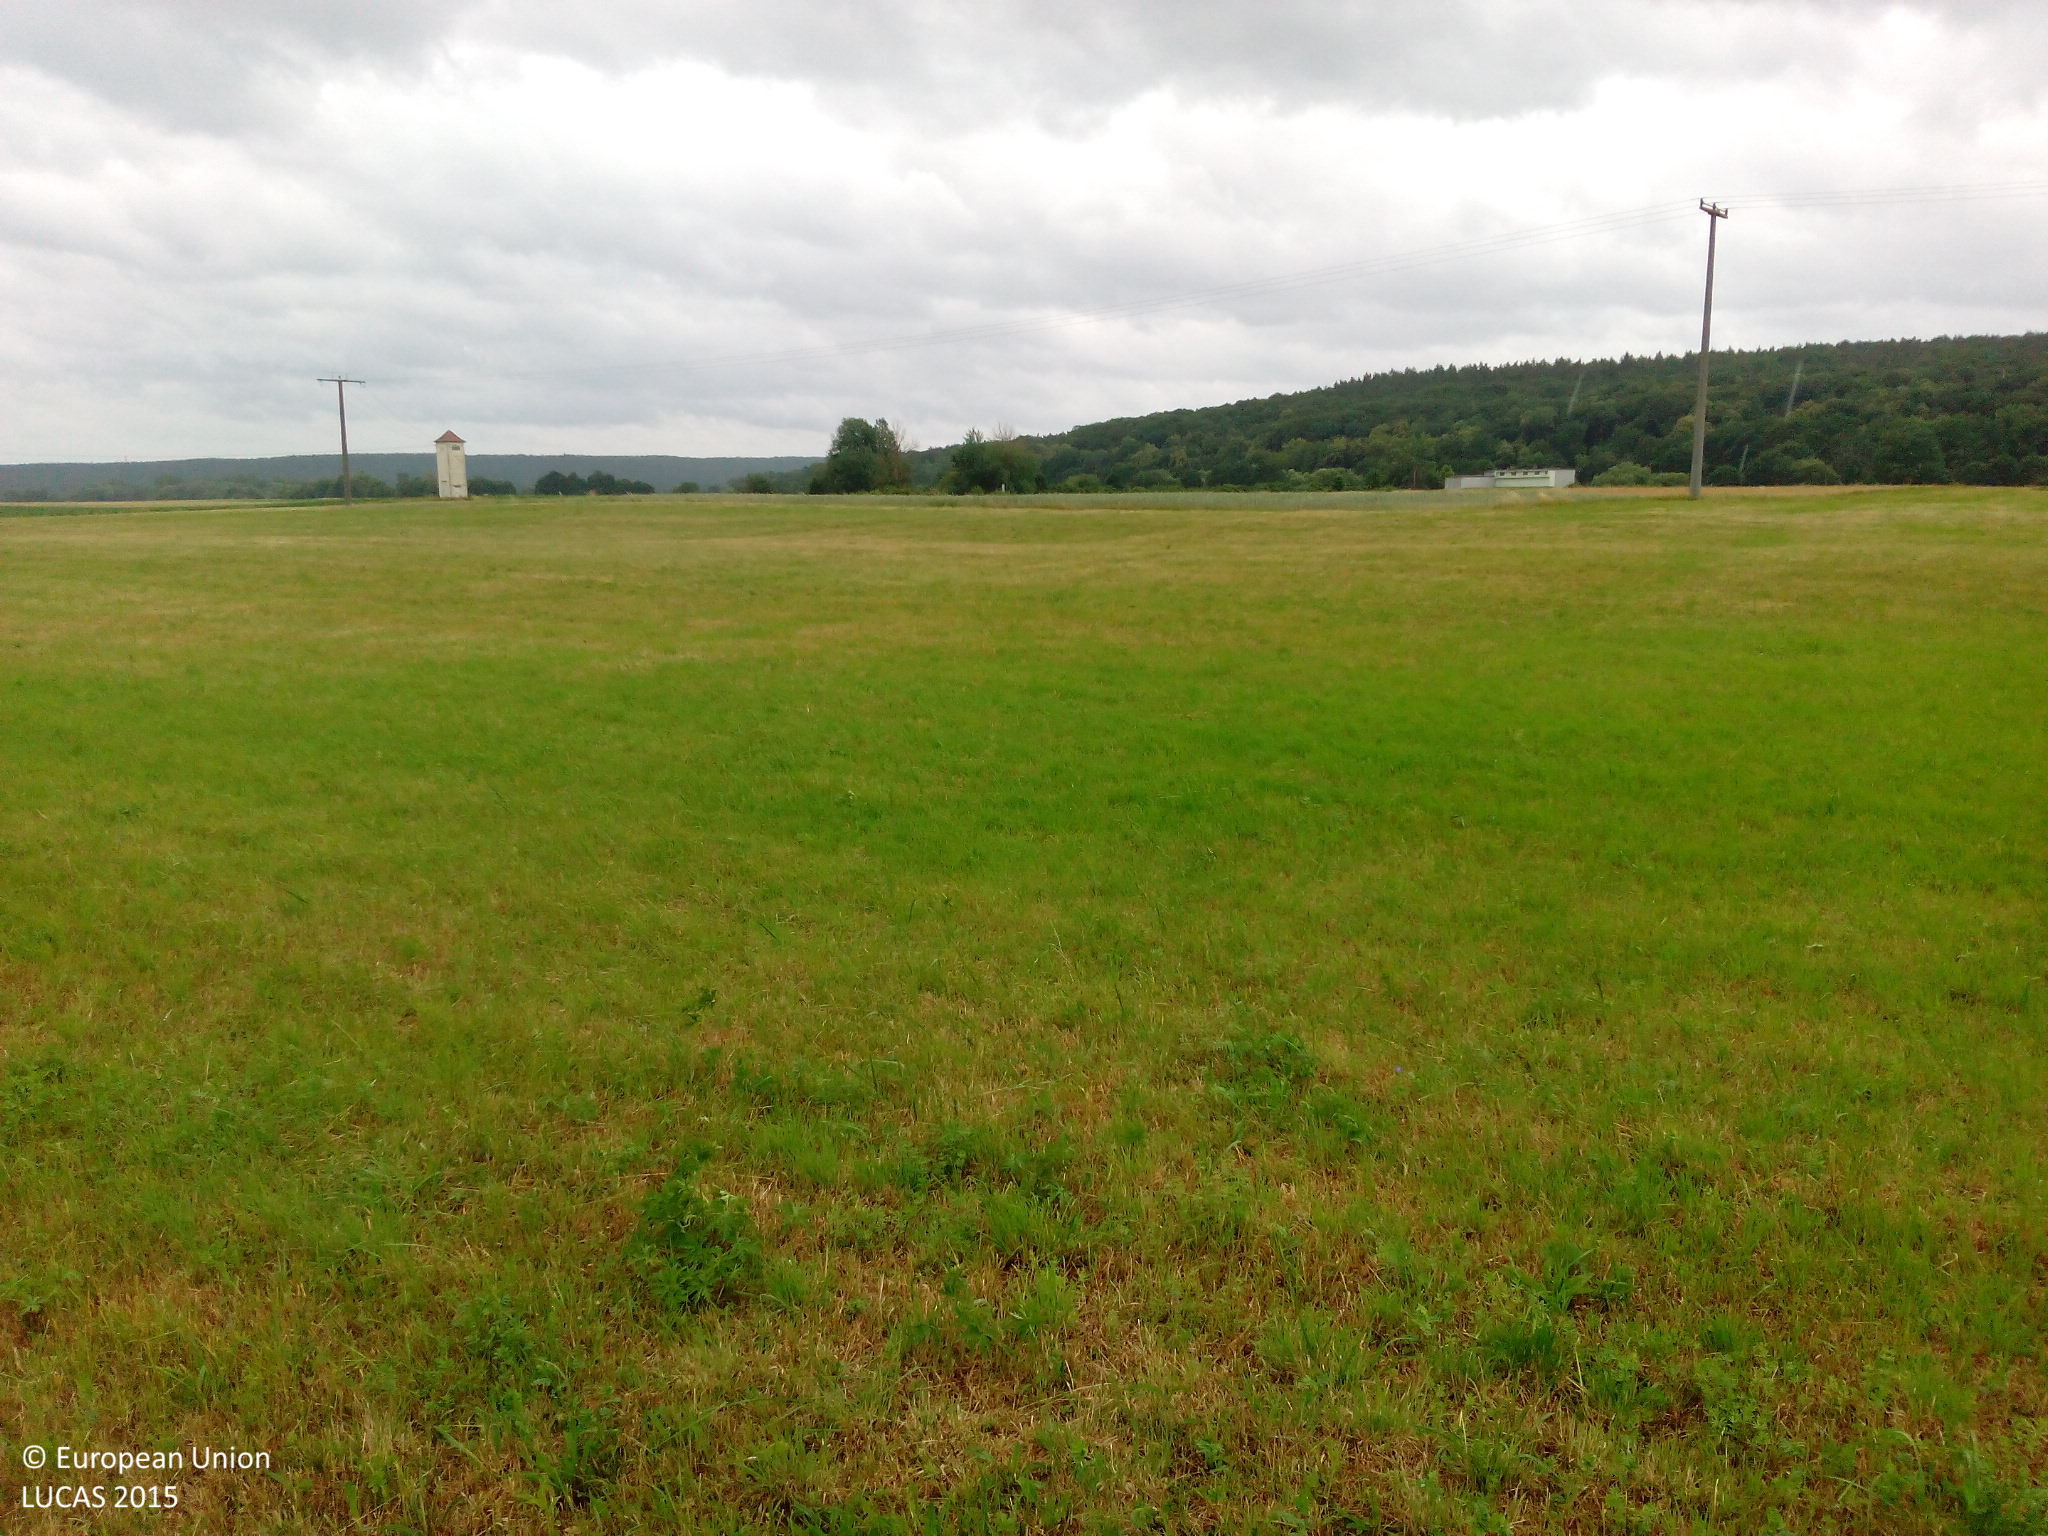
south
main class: Grassland
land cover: Grassland without tree/shrub cover
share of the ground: > 75 %
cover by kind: herbaceous plants 100 %
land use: Agriculture (excluding fallow land and kitchen gardens)
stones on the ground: < 10 %
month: June
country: DE
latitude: 49.8567
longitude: 10.9316
